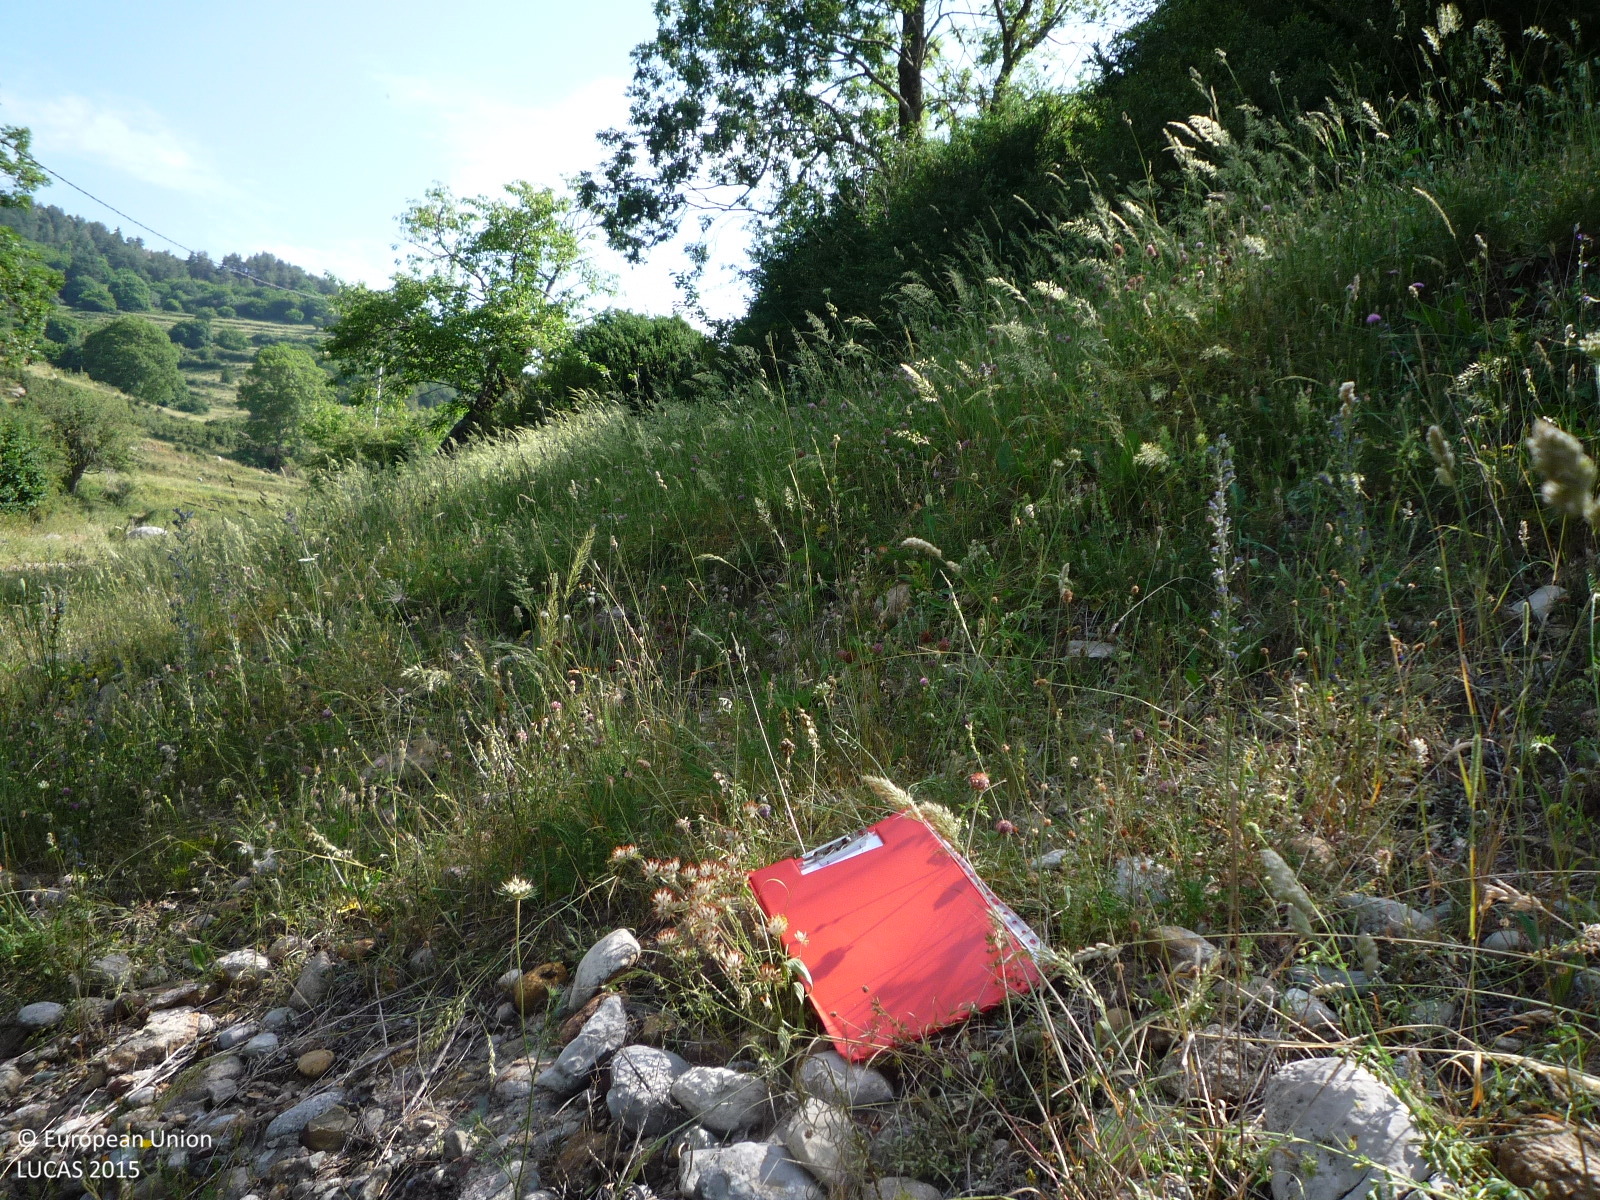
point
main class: Woodland
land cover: Broadleaved woodland
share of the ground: 50 - 75 %
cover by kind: broadleaved forest trees 50 %, herbaceous plants 50 %
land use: Semi-natural and natural areas not in use
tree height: > 5 m
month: July
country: ES
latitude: 42.1870
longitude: 1.9364
